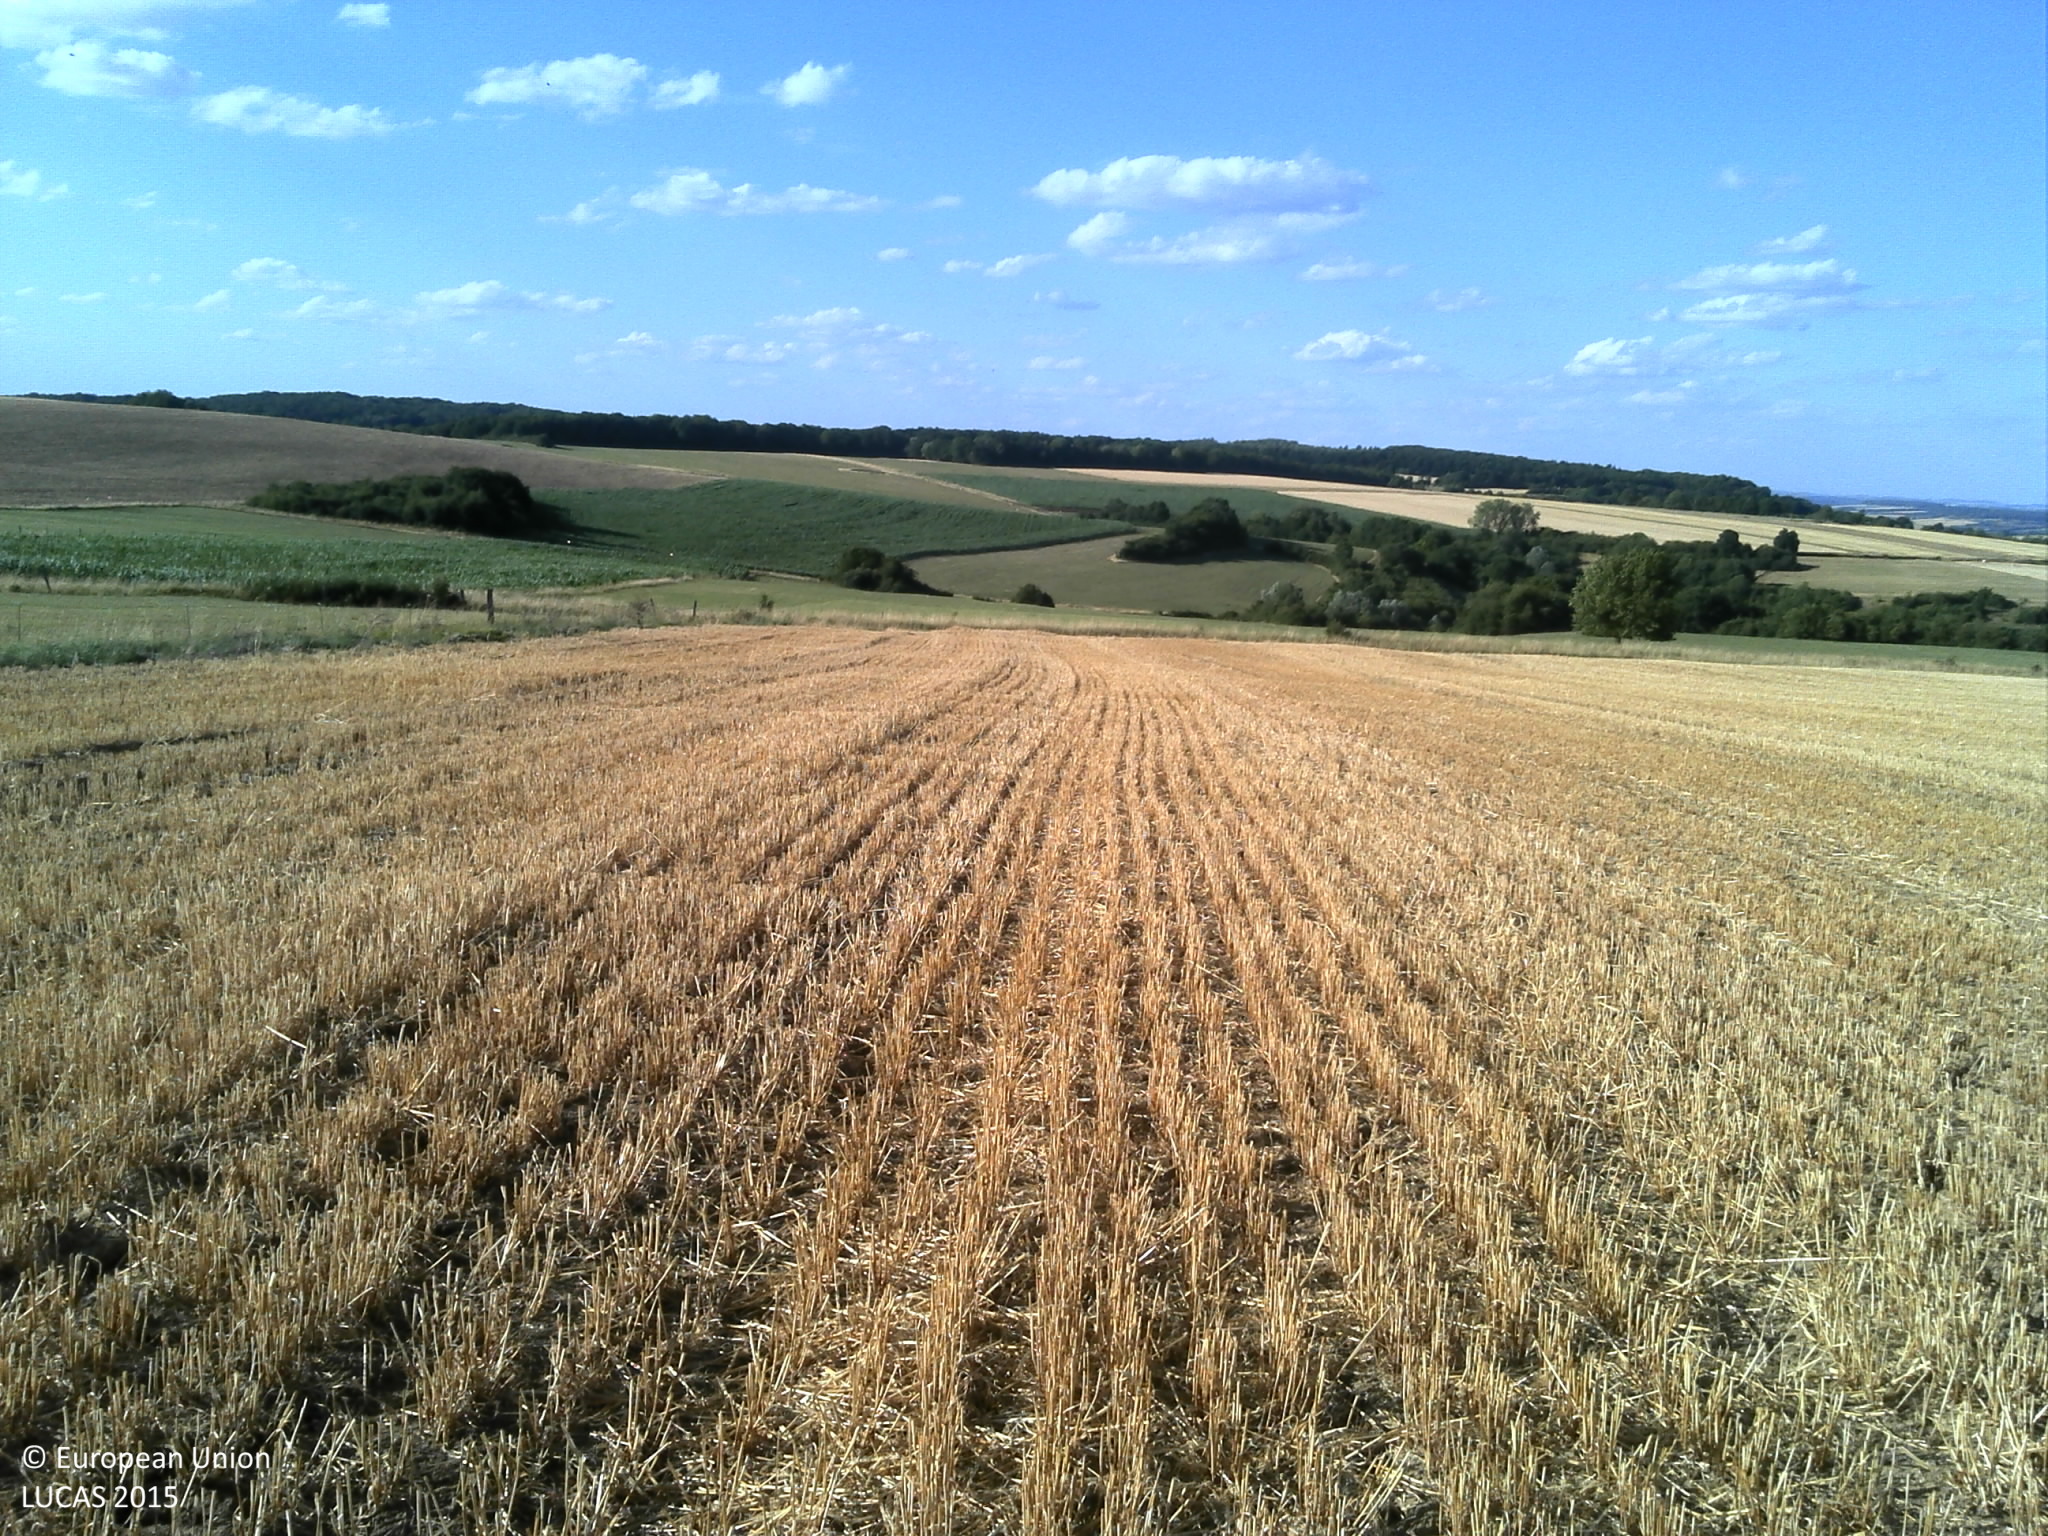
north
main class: Cropland
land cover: Barley
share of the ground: > 75 %
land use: Agriculture (excluding fallow land and kitchen gardens)
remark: Harvested field
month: July
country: FR
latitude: 49.1073
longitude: 7.2471
